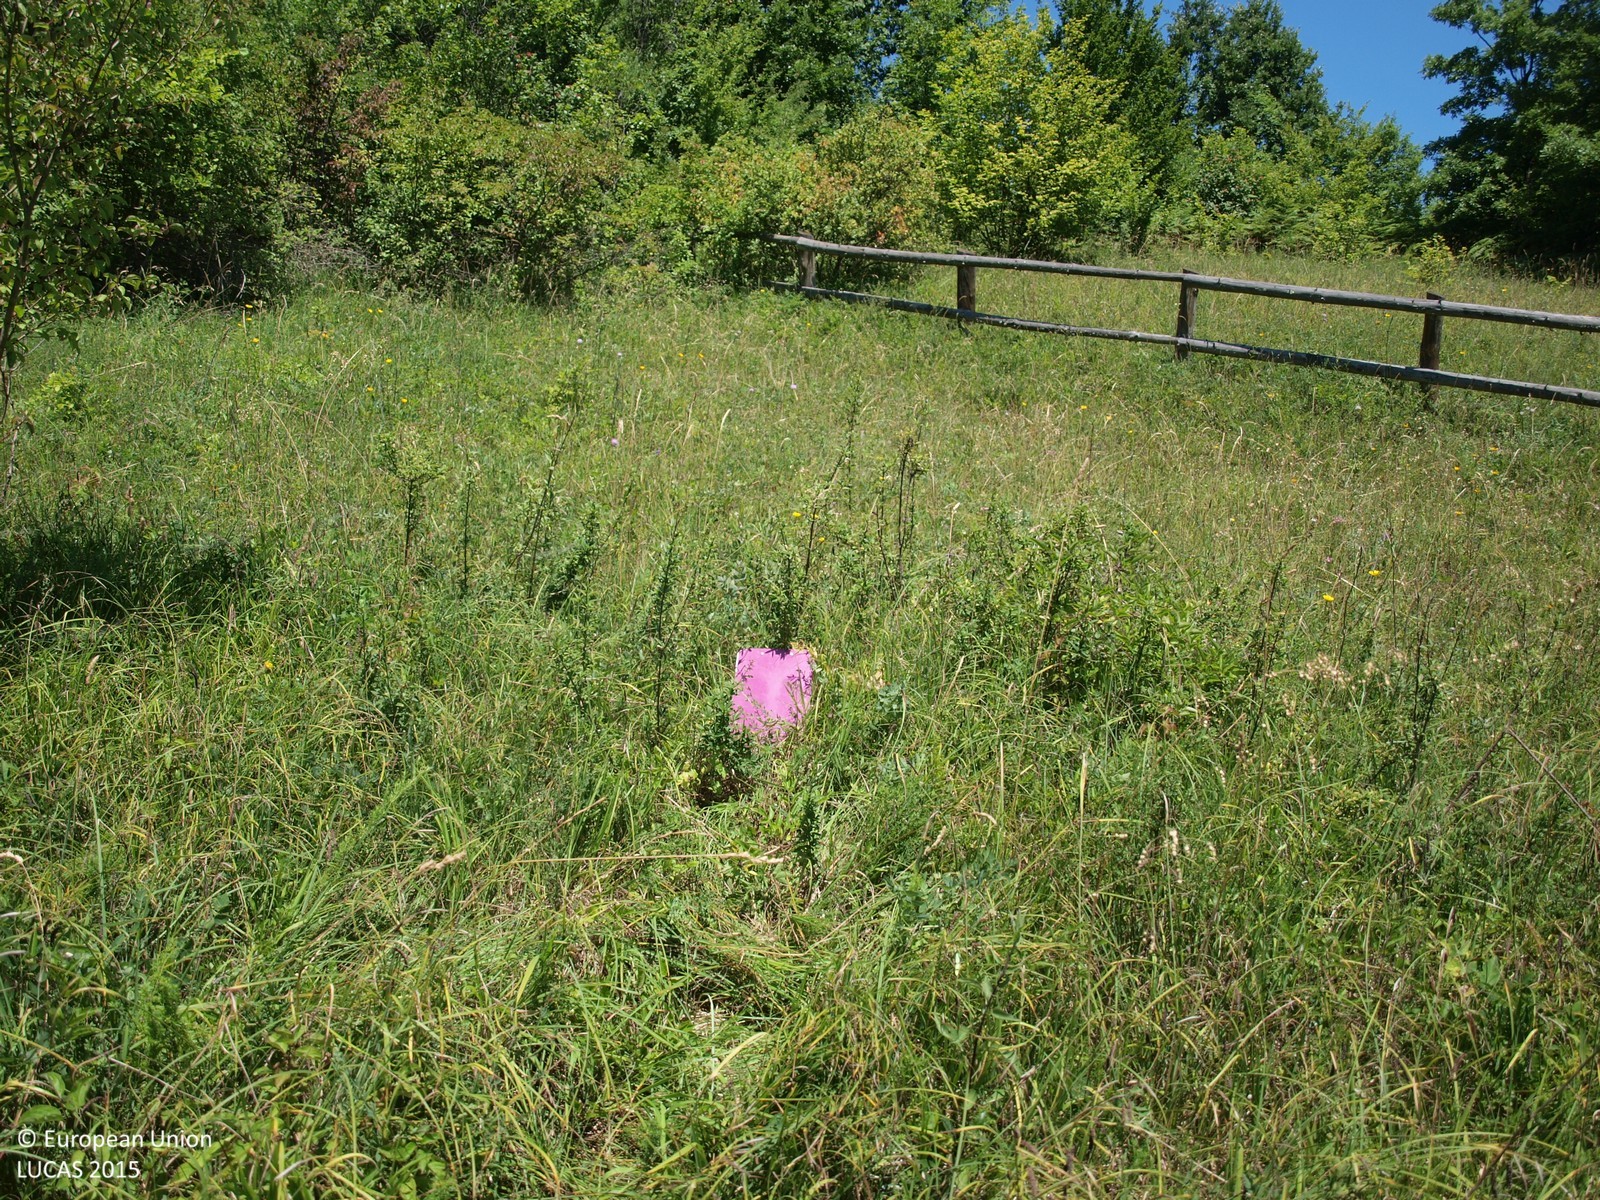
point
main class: Grassland
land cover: Grassland with sparse tree/shrub cover
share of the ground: > 75 %
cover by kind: herbaceous plants 95 %, broadleaved forest trees 5 %
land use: Agriculture (excluding fallow land and kitchen gardens)
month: July
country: HR
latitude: 45.9071
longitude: 15.7599
